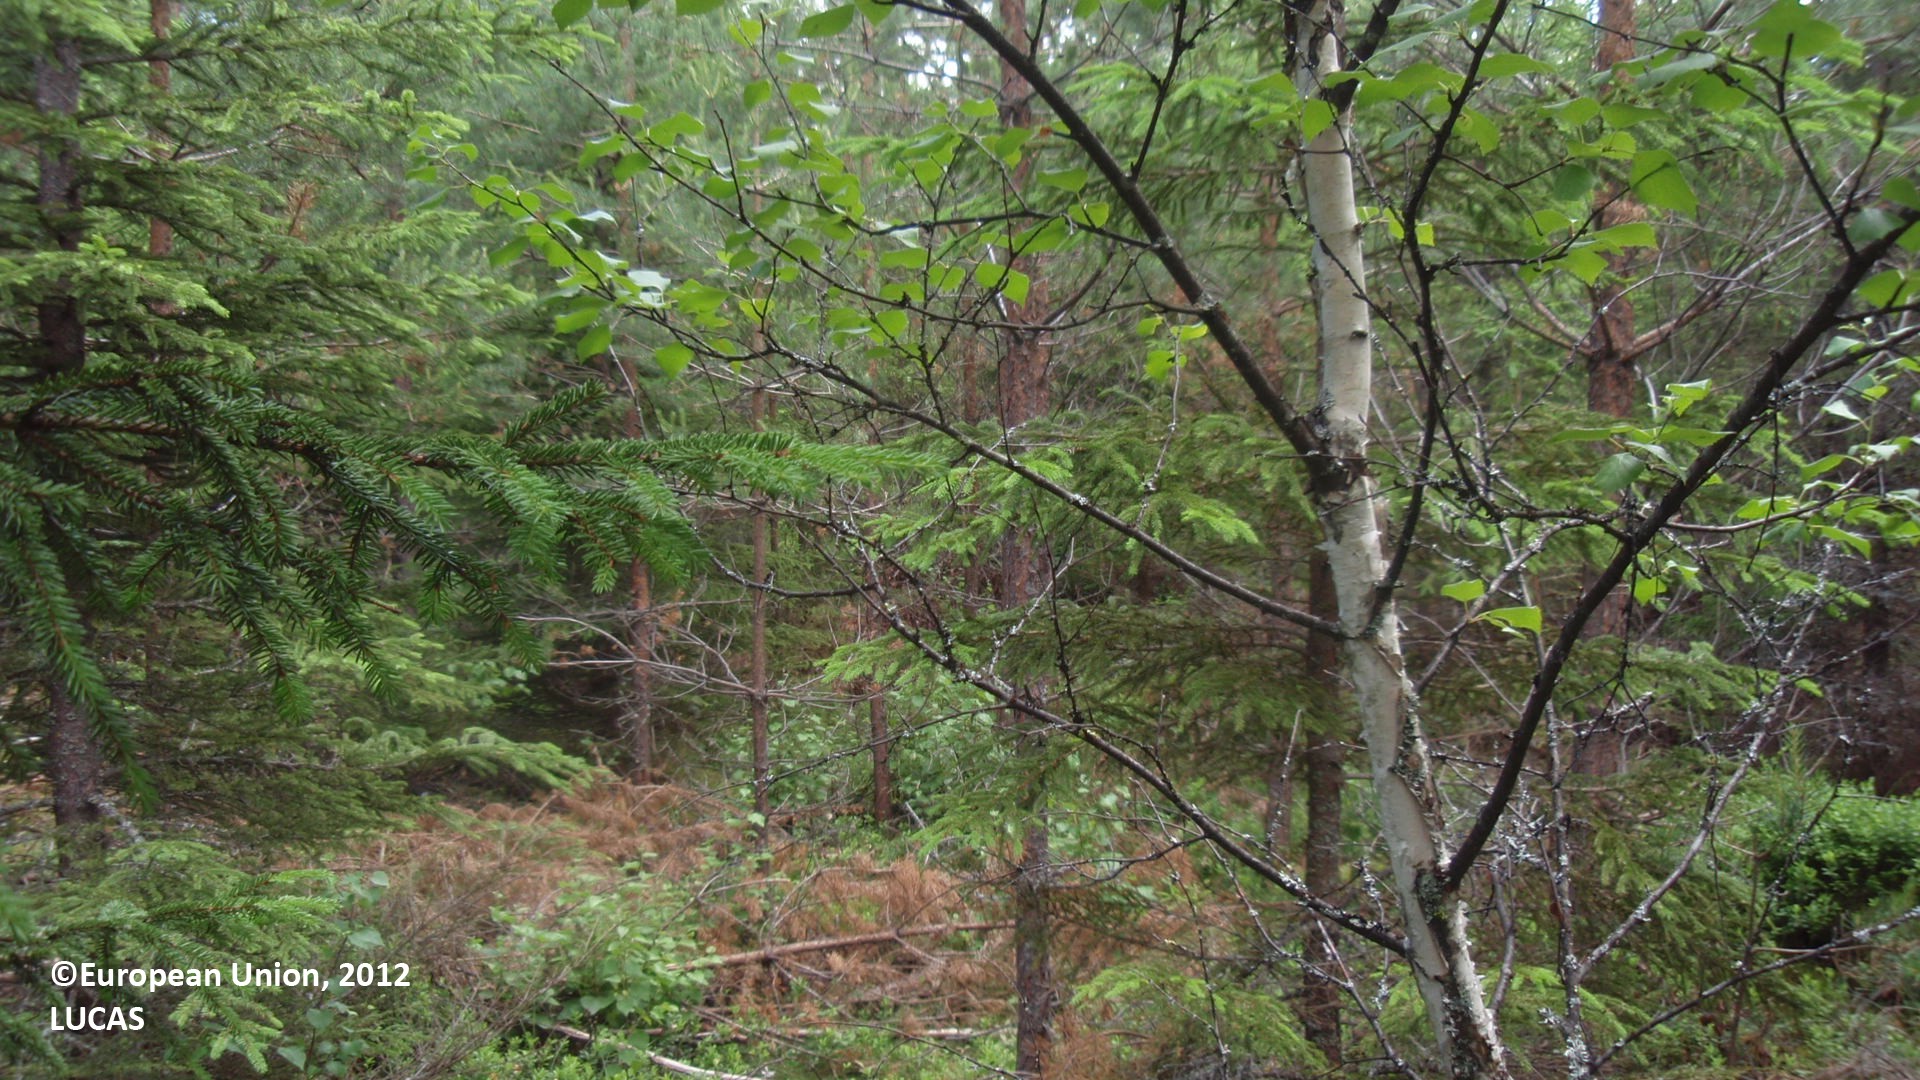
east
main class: Woodland
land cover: Spruce dominated coniferous woodland
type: boreal forest
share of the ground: 50 - 75 %
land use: Forestry
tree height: < 5 m
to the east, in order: Spruce dominated coniferous woodland; Ditches and canals; Spruce dominated coniferous woodland; Rocks and stones; Spruce dominated coniferous woodland; Ditches and canals; Grassland with sparse tree/shrub cover; Pine dominated coniferous woodland
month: July
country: FI
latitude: 61.6692
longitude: 28.0836
